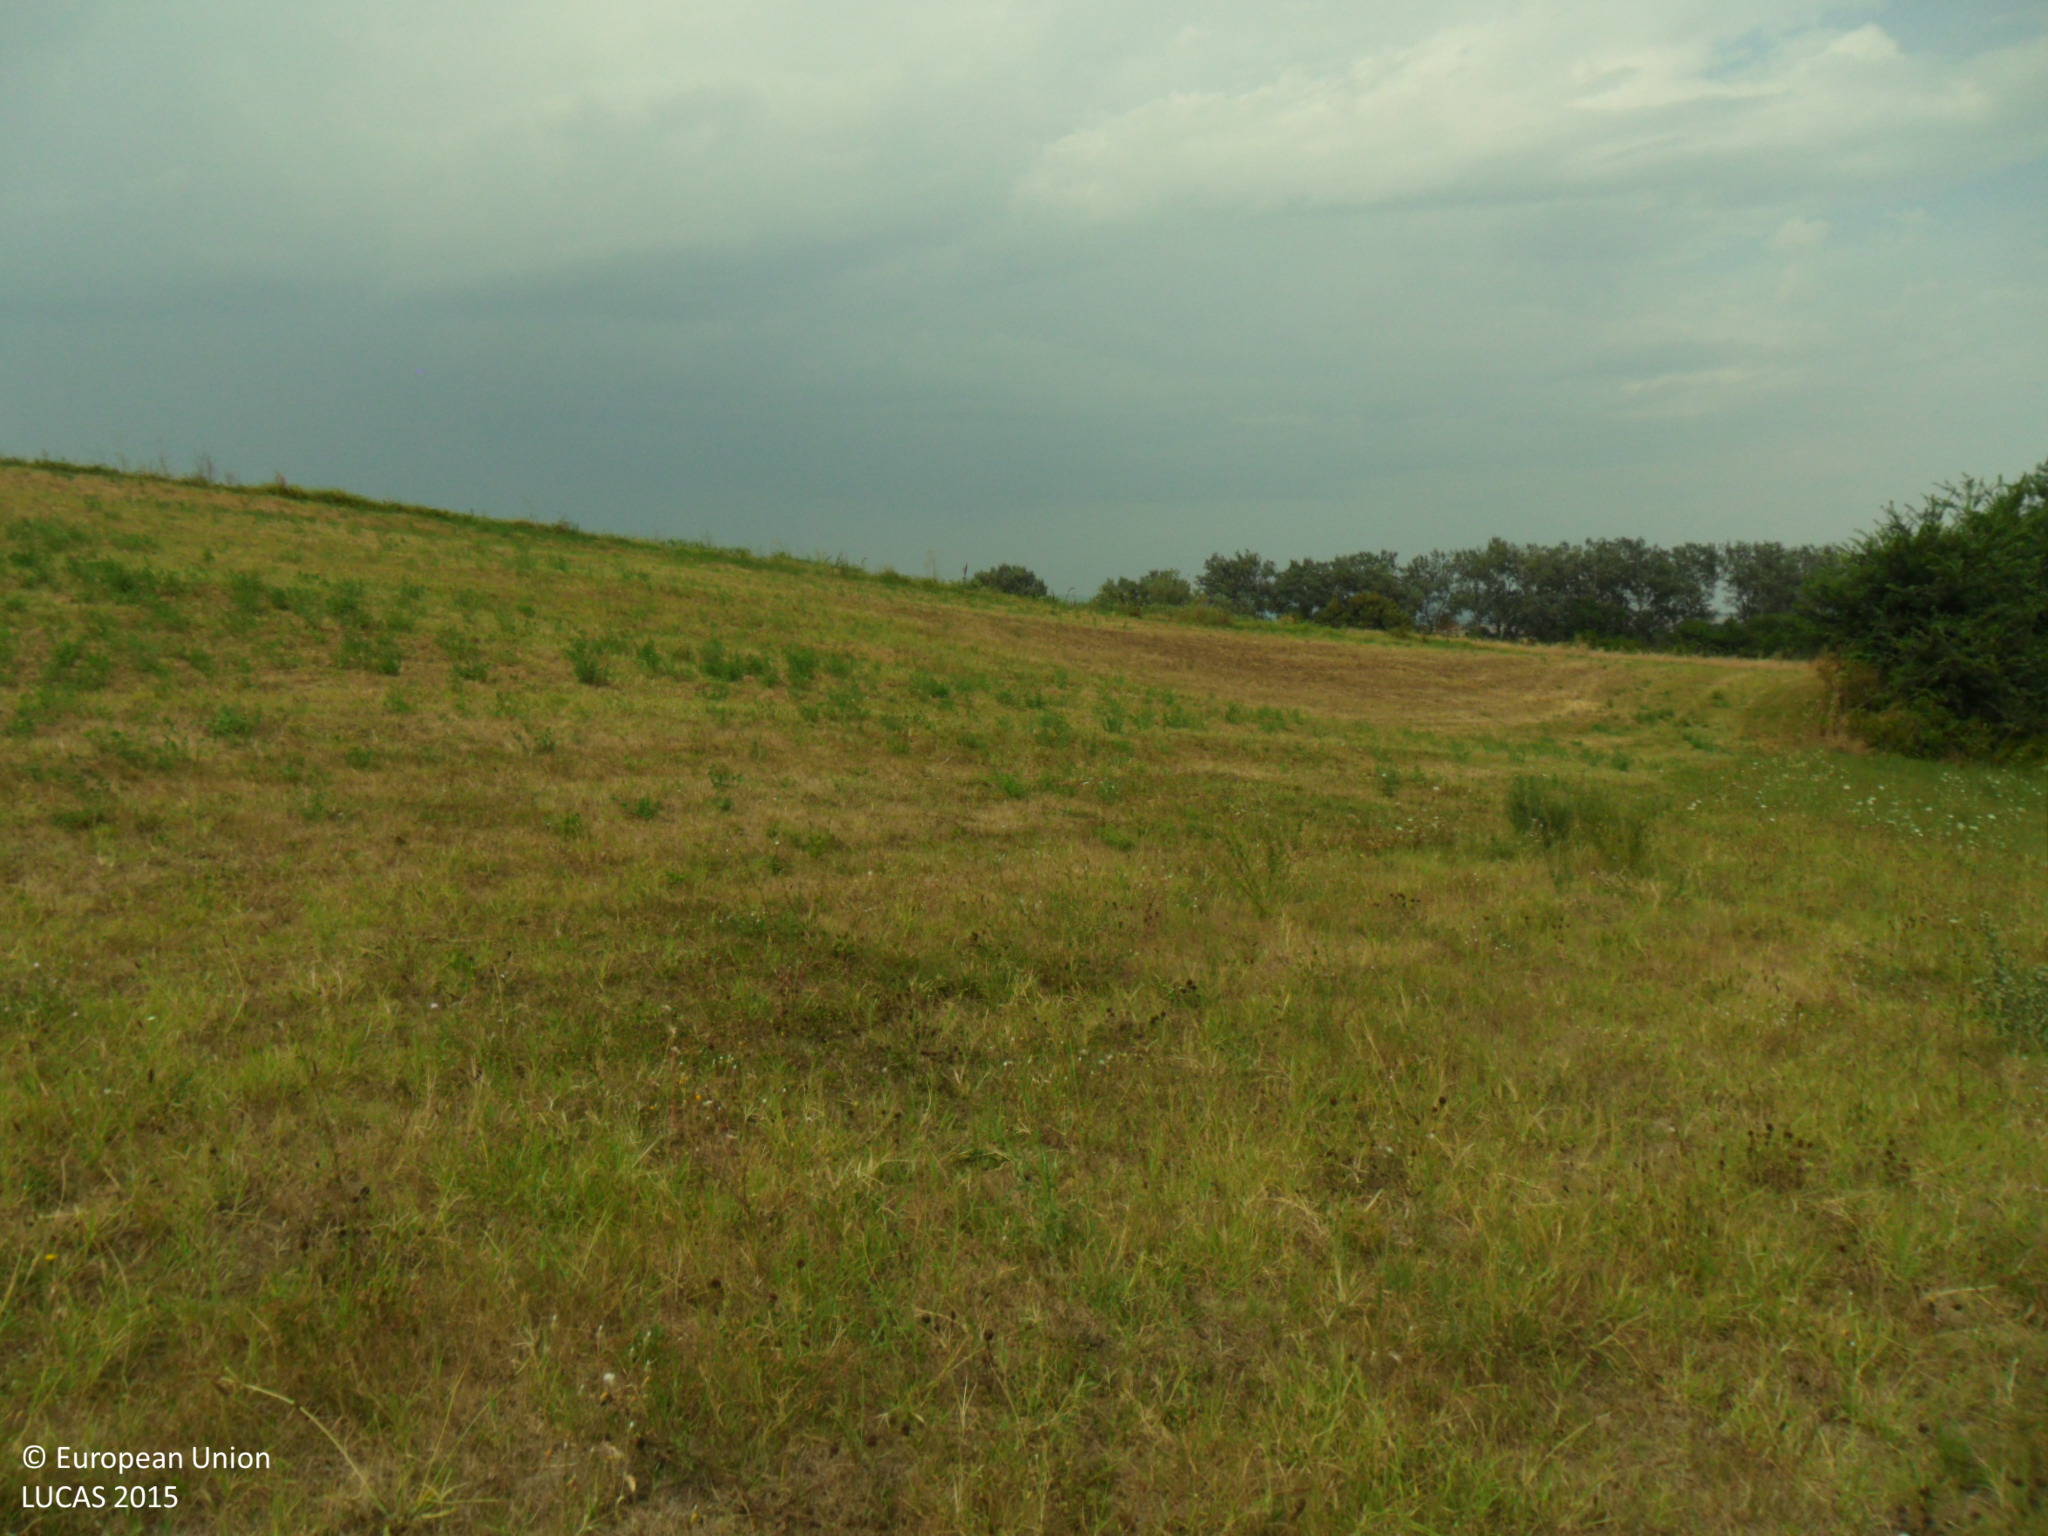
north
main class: Grassland
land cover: Spontaneously vegetated surfaces
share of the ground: > 75 %
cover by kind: herbaceous plants 100 %
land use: Fallow land
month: August
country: BG
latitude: 43.0117
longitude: 26.6535
